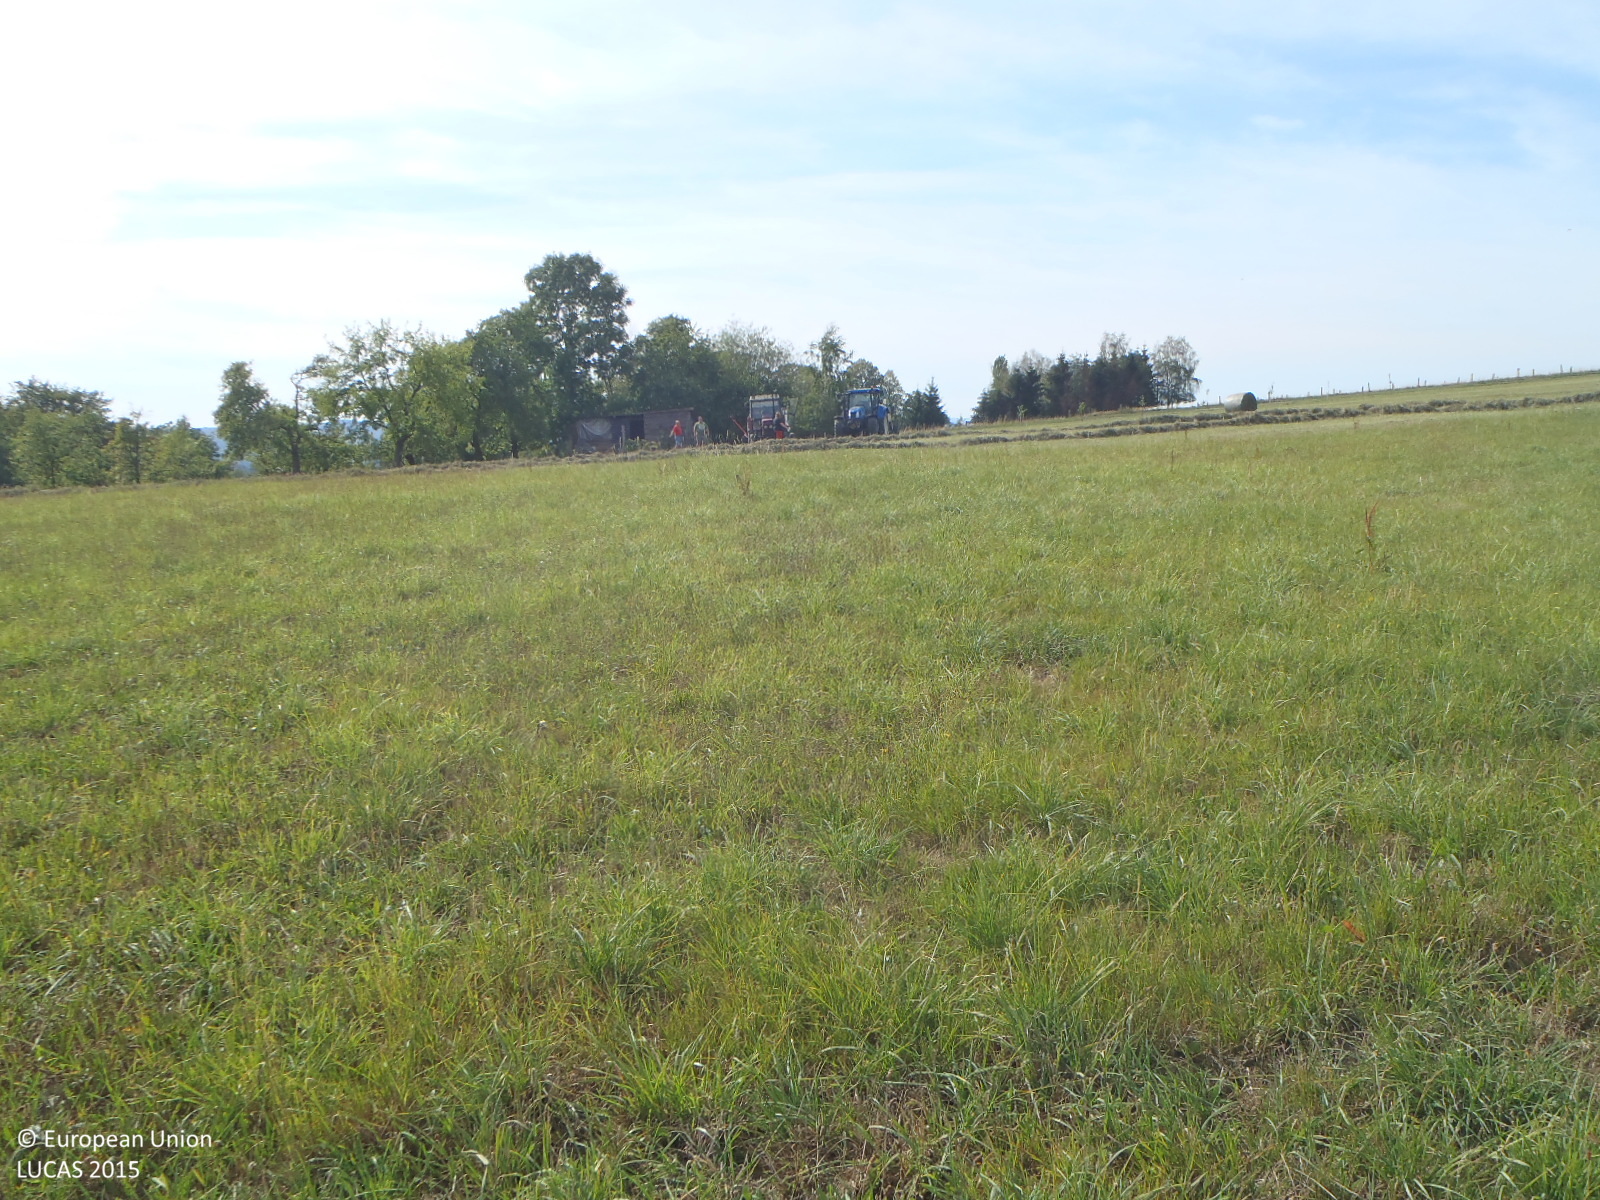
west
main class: Grassland
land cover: Grassland without tree/shrub cover
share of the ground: > 75 %
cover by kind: herbaceous plants 100 %
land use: Agriculture (excluding fallow land and kitchen gardens)
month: August
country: CZ
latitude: 50.8318
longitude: 14.9865
